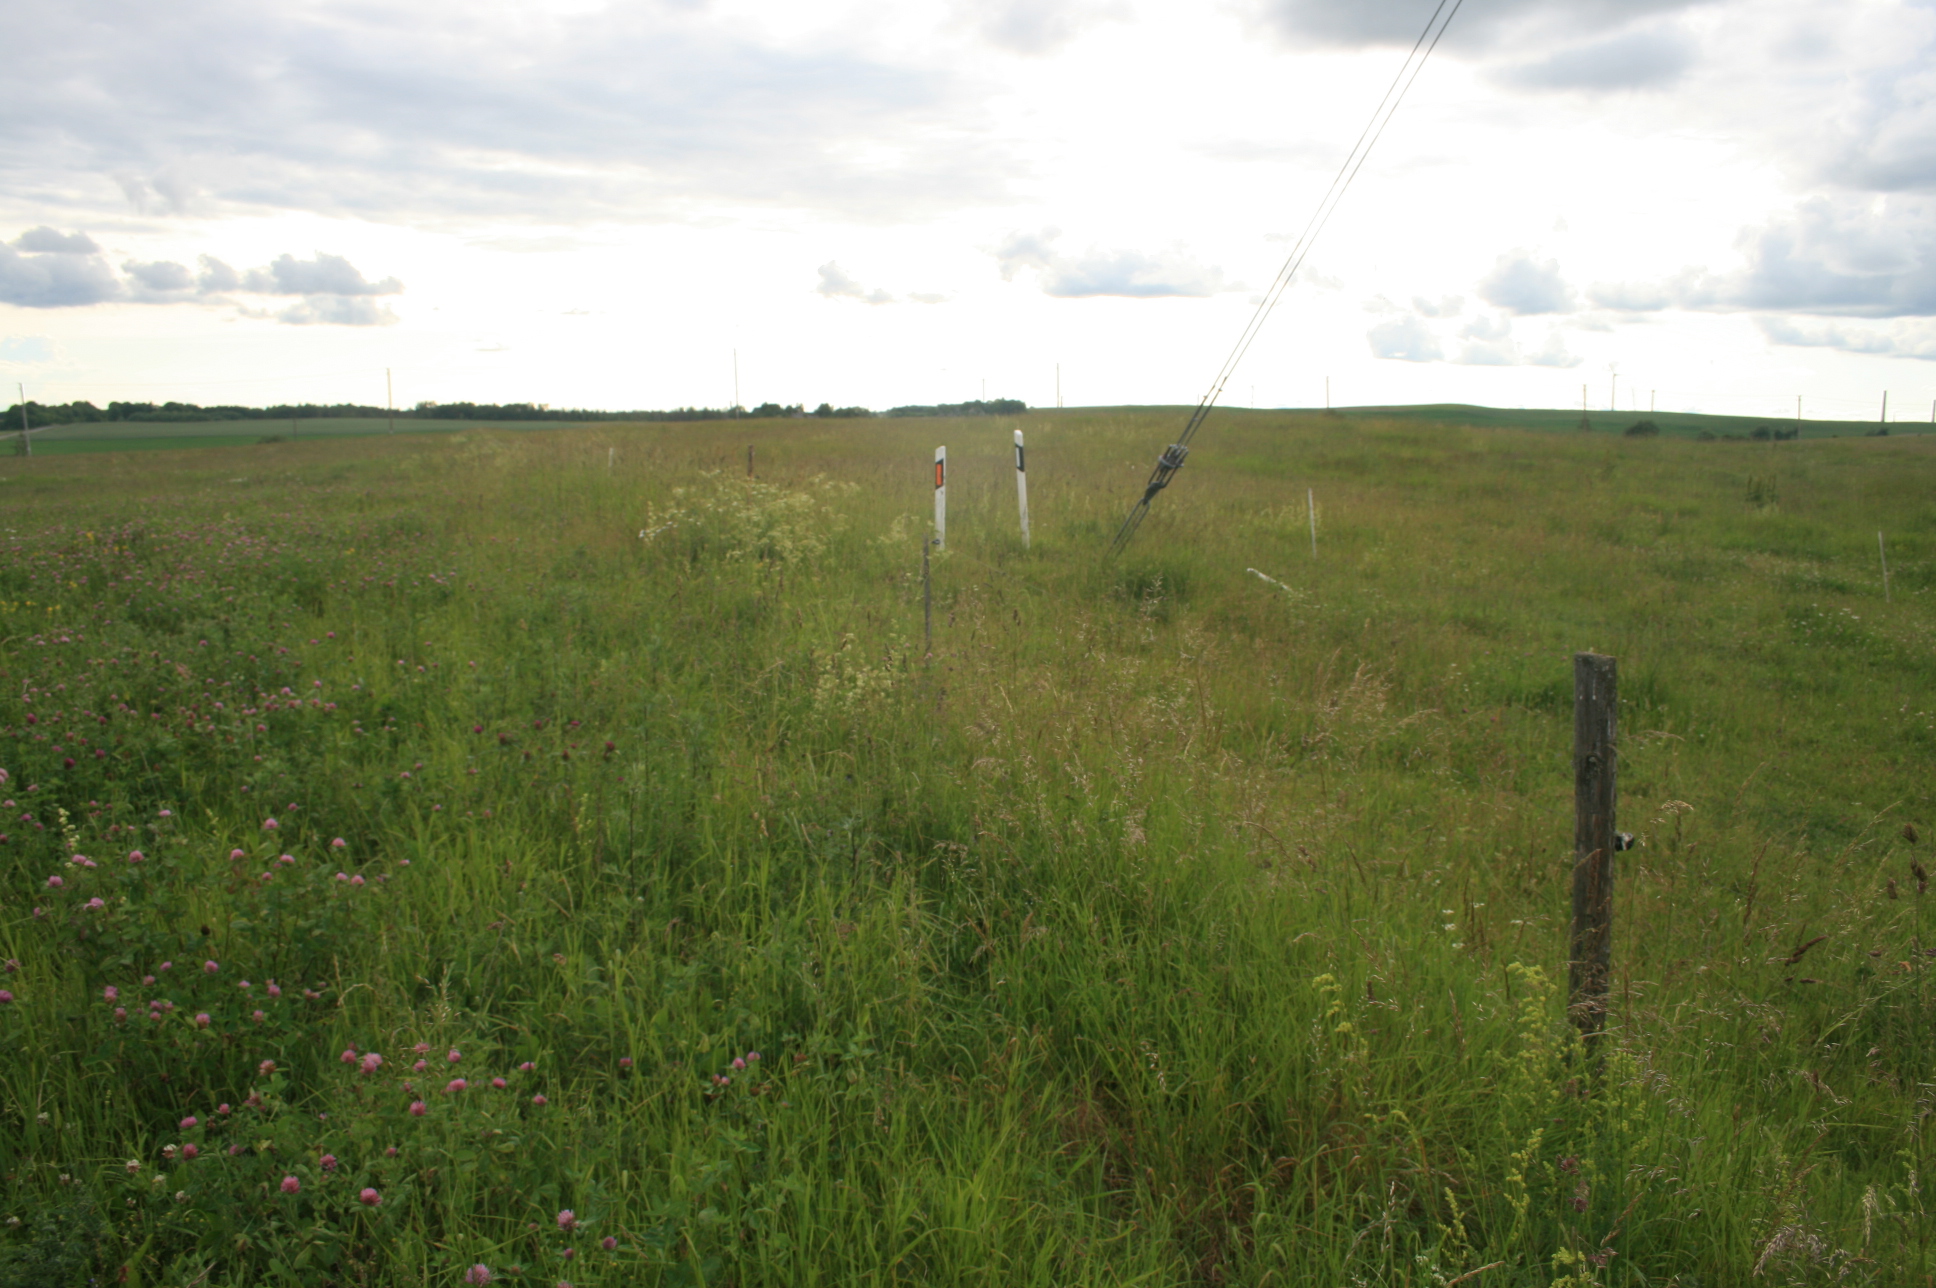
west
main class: Grassland
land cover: Grassland without tree/shrub cover
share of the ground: > 75 %
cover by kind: herbaceous plants 100 %
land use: Agriculture (excluding fallow land and kitchen gardens)
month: June
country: LT
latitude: 55.1199
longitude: 22.1138
